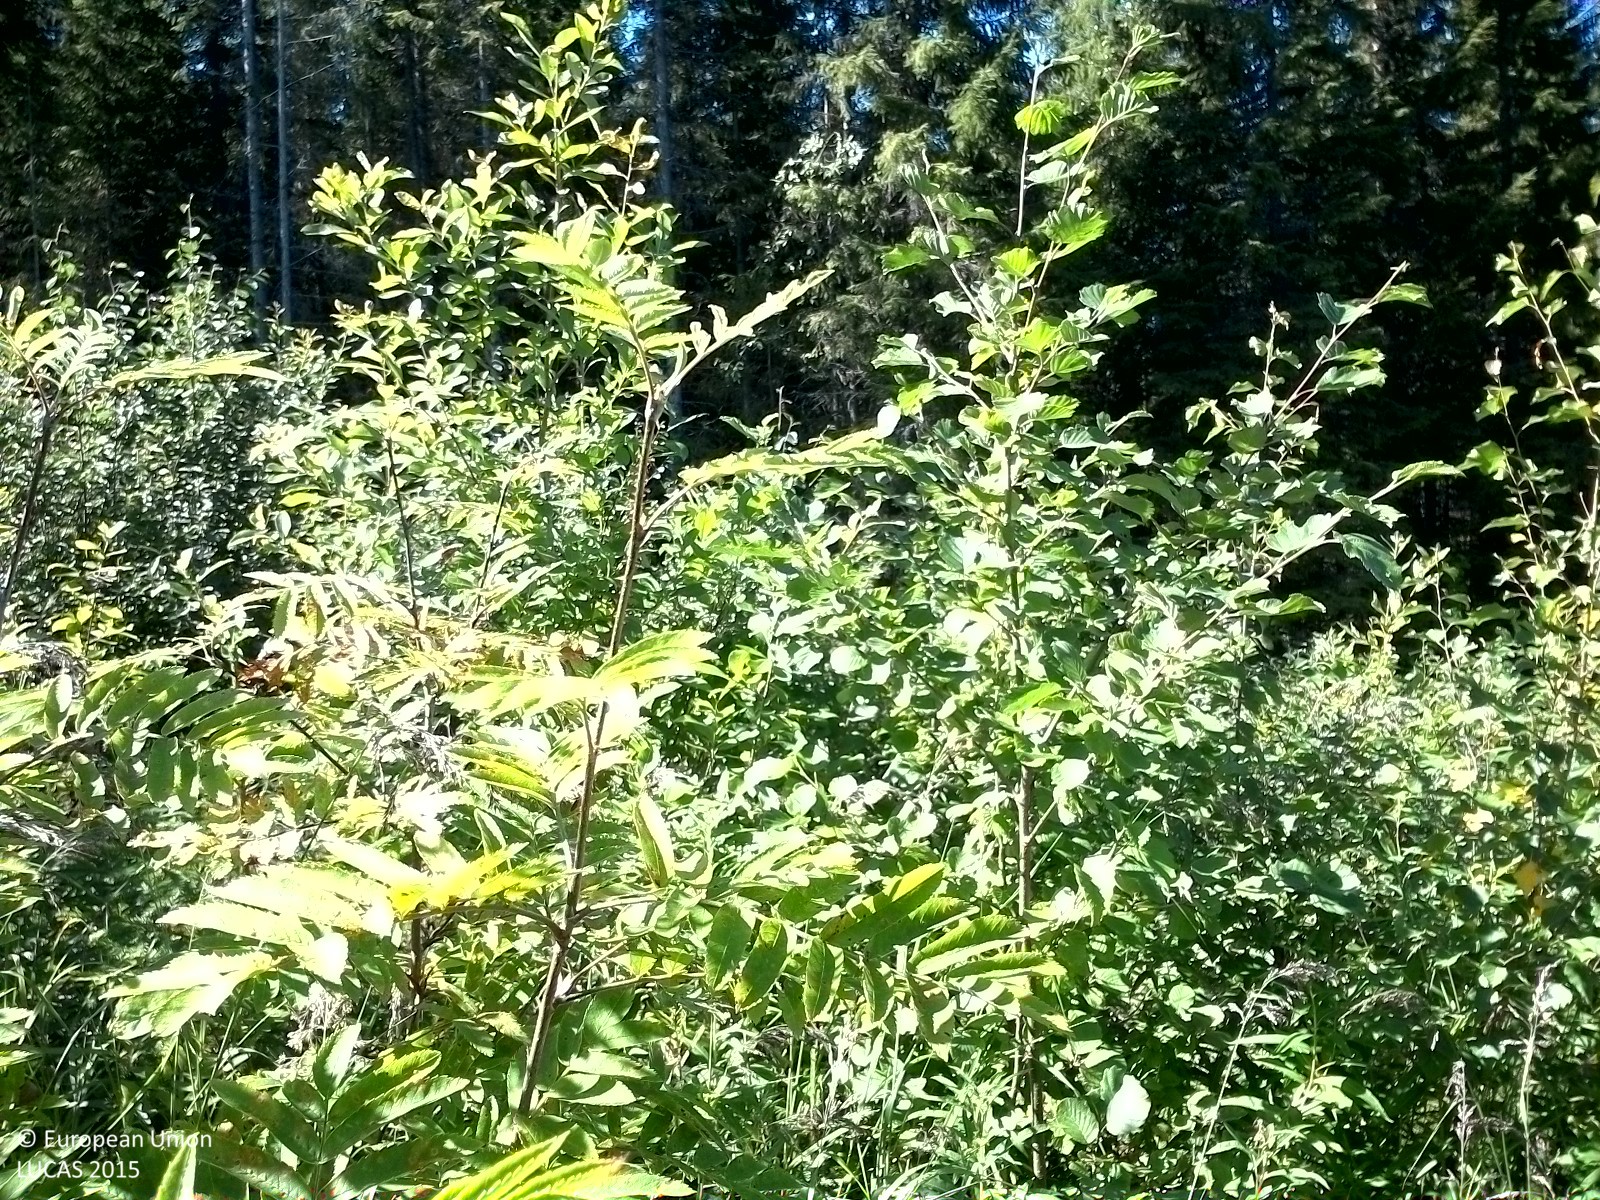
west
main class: Artificial land
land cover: Other artificial areas
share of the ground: > 75 %
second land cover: Broadleaved woodland
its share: > 75 %
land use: Electricity, gas and thermal power distribution
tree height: < 5 m
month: August
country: SE
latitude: 62.3295
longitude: 16.4464
